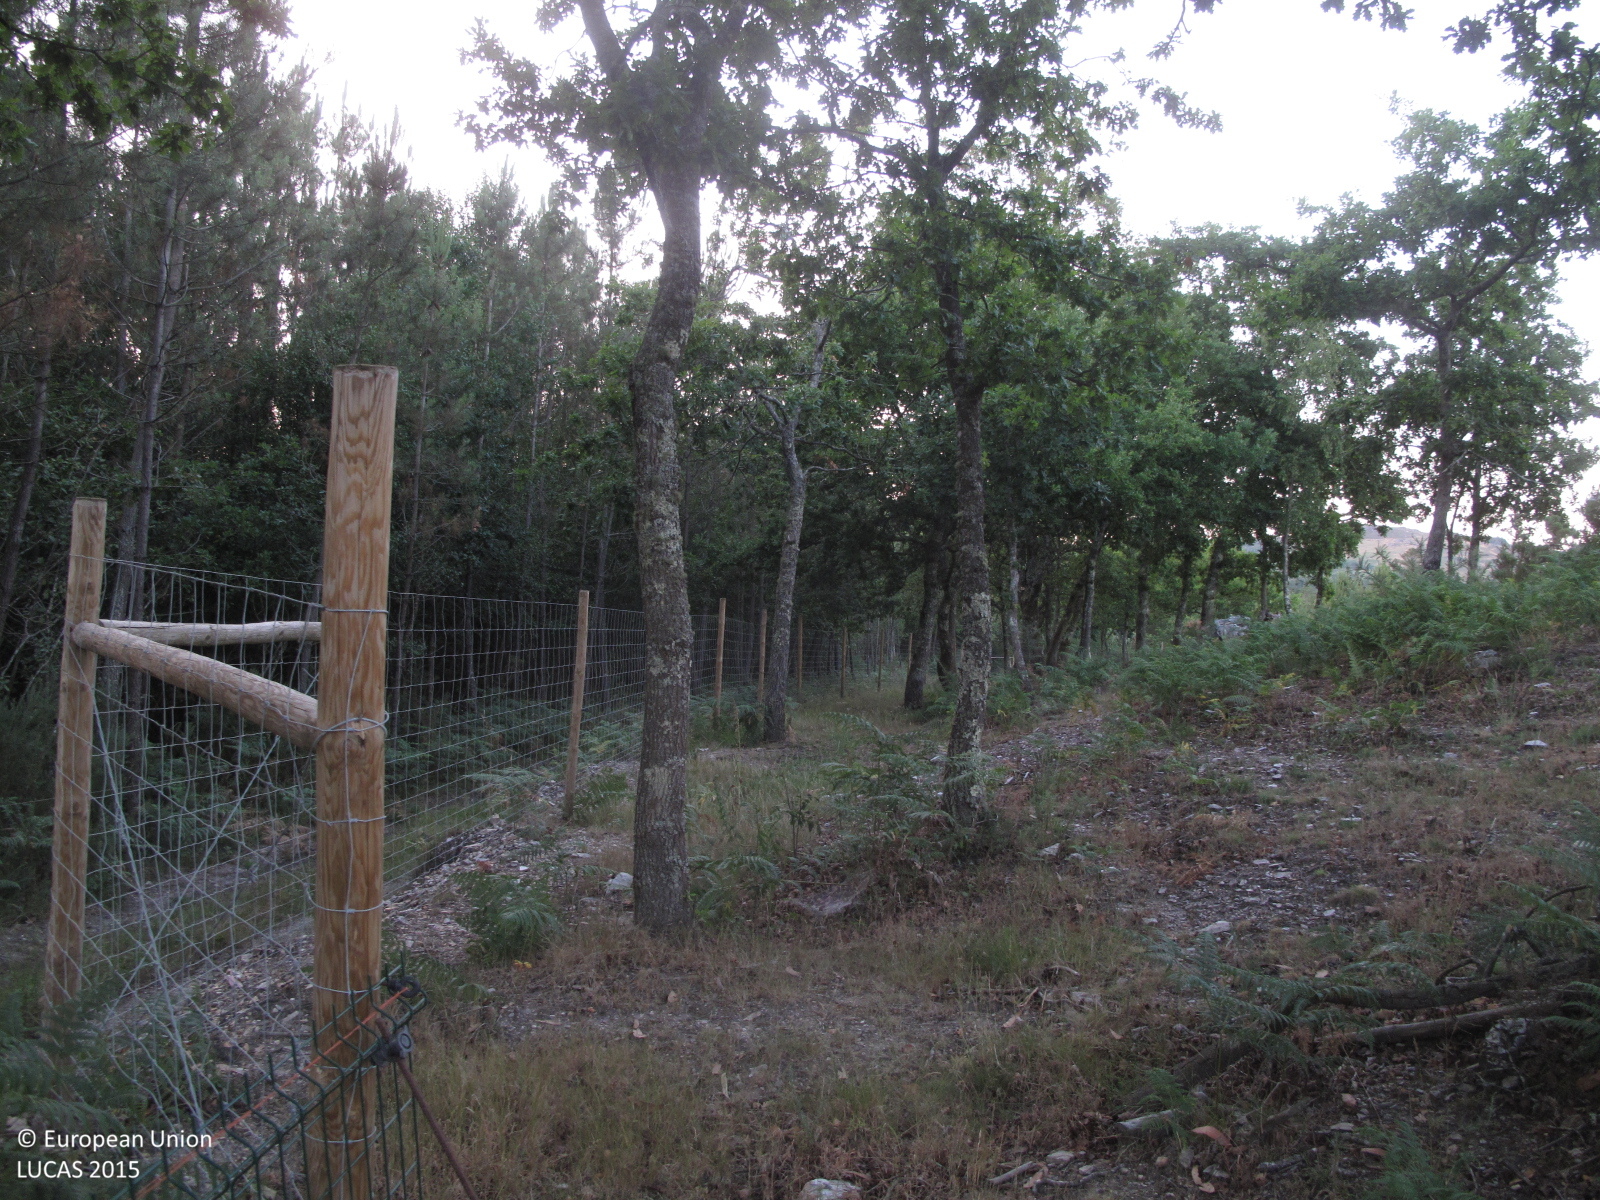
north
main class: Woodland
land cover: Broadleaved woodland
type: exotic forest
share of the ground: 50 - 75 %
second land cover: Shrubland without tree cover
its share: 10 - 25 %
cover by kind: broadleaved forest trees 70 %, shrubs 20 %, herbaceous plants 10 %
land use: Forestry
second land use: Agriculture (excluding fallow land and kitchen gardens)
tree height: > 5 m
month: July
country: ES
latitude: 43.2731
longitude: -8.0216
